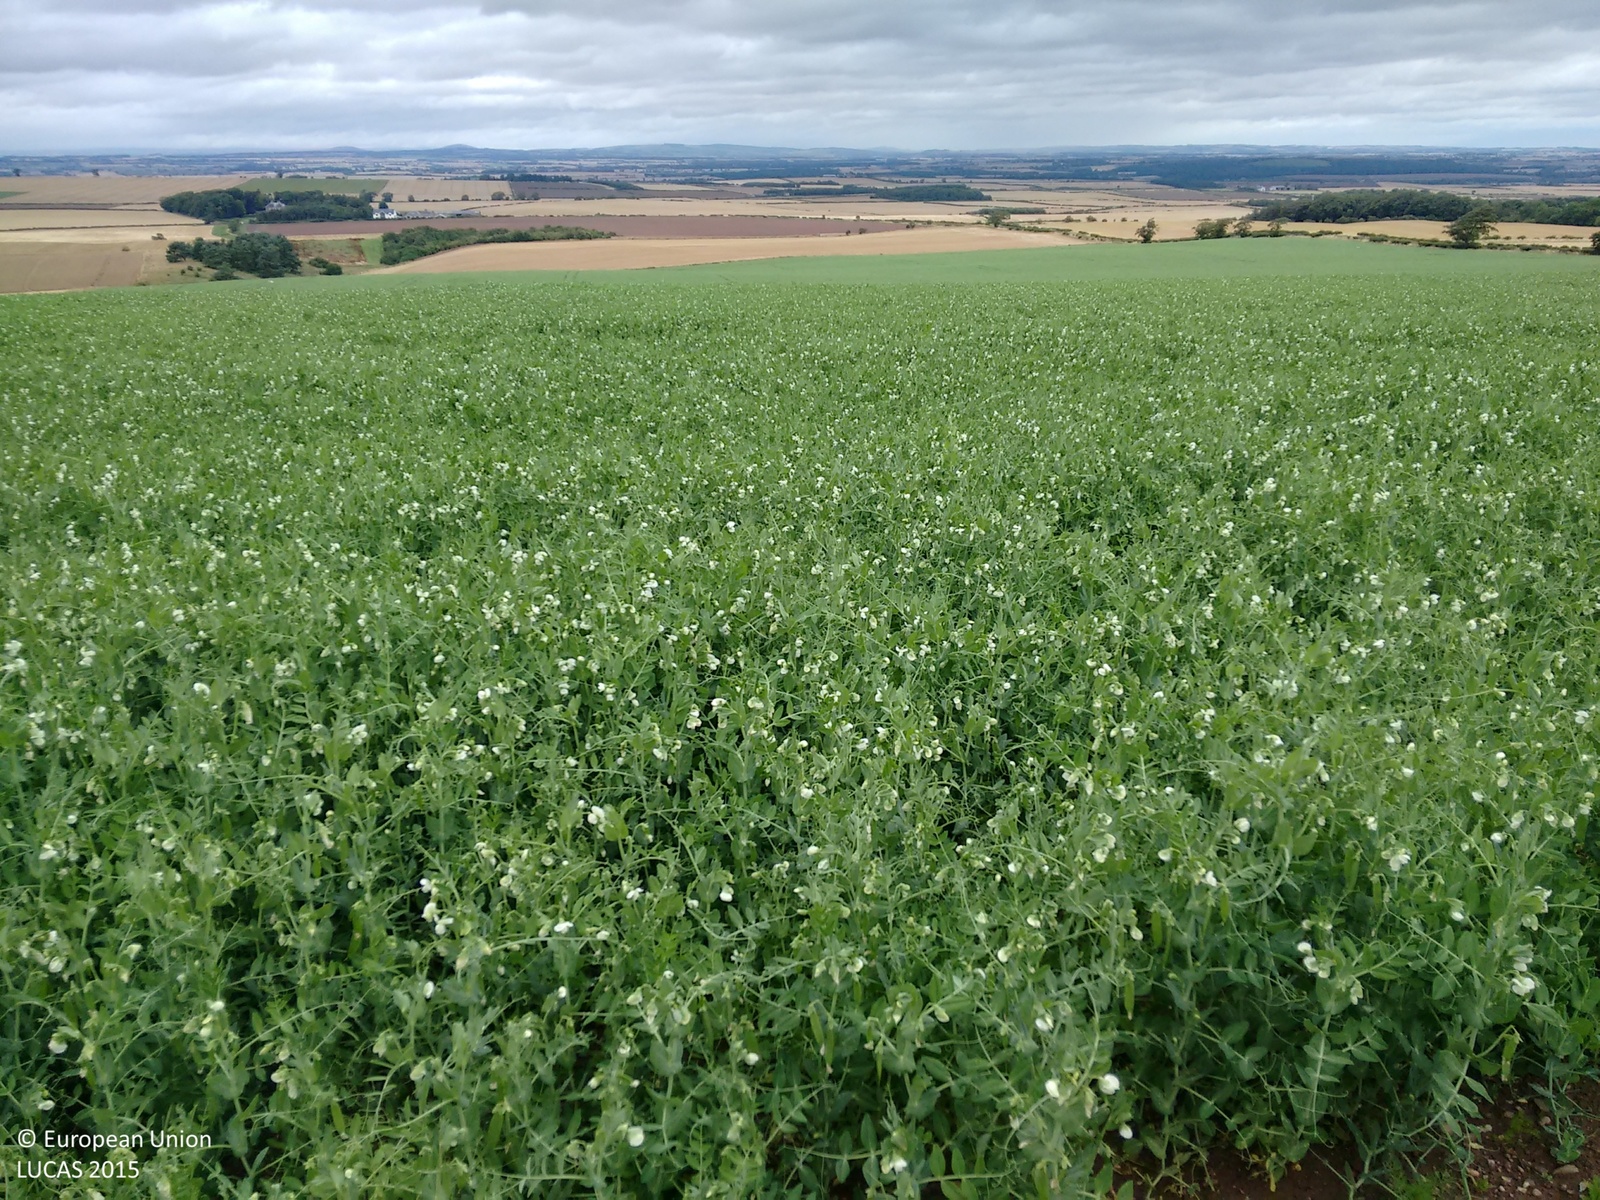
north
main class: Cropland
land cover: Dry pulses
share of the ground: > 75 %
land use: Agriculture (excluding fallow land and kitchen gardens)
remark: Tilled/Sowed
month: August
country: GB
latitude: 55.5940
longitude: -2.2920
